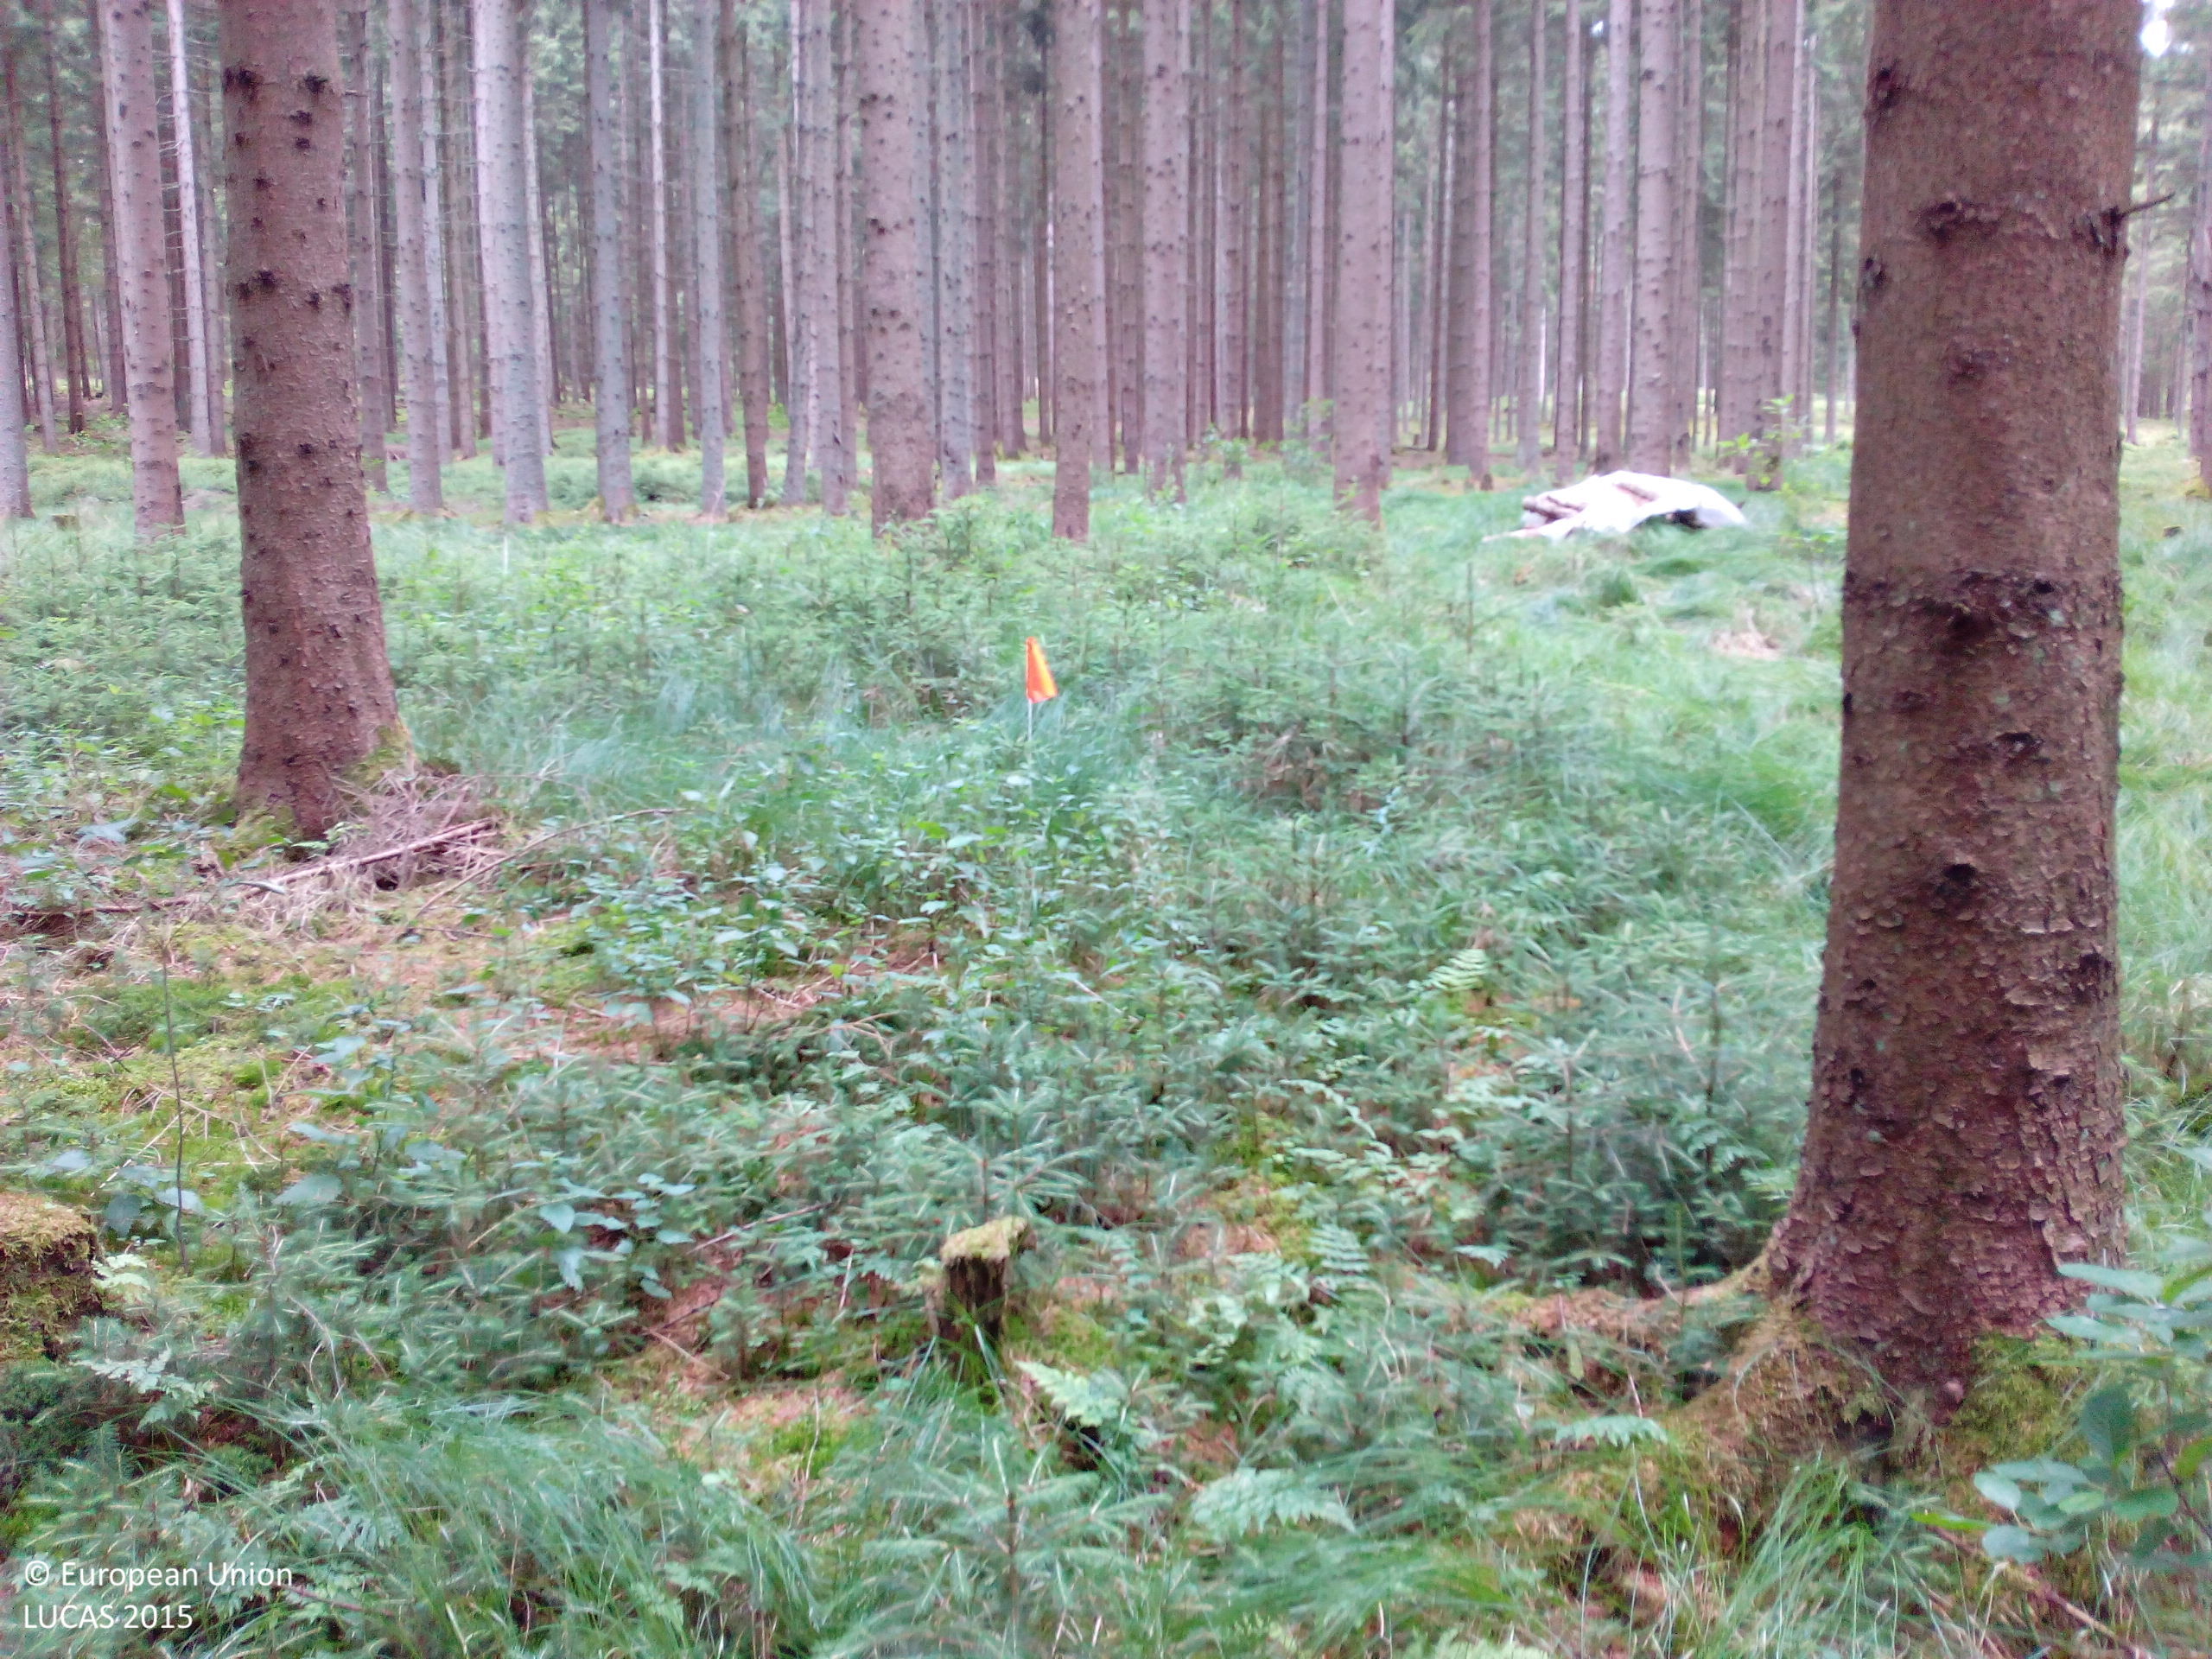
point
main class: Woodland
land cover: Spruce dominated coniferous woodland
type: hemiboreal forest and nemoral coniferous forest and mixed broadleaved-coniferous forest
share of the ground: 50 - 75 %
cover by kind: coniferous forest trees 70 %, herbaceous plants 30 %
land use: Forestry
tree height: > 5 m
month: July
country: DE
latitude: 49.1017
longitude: 12.9718
